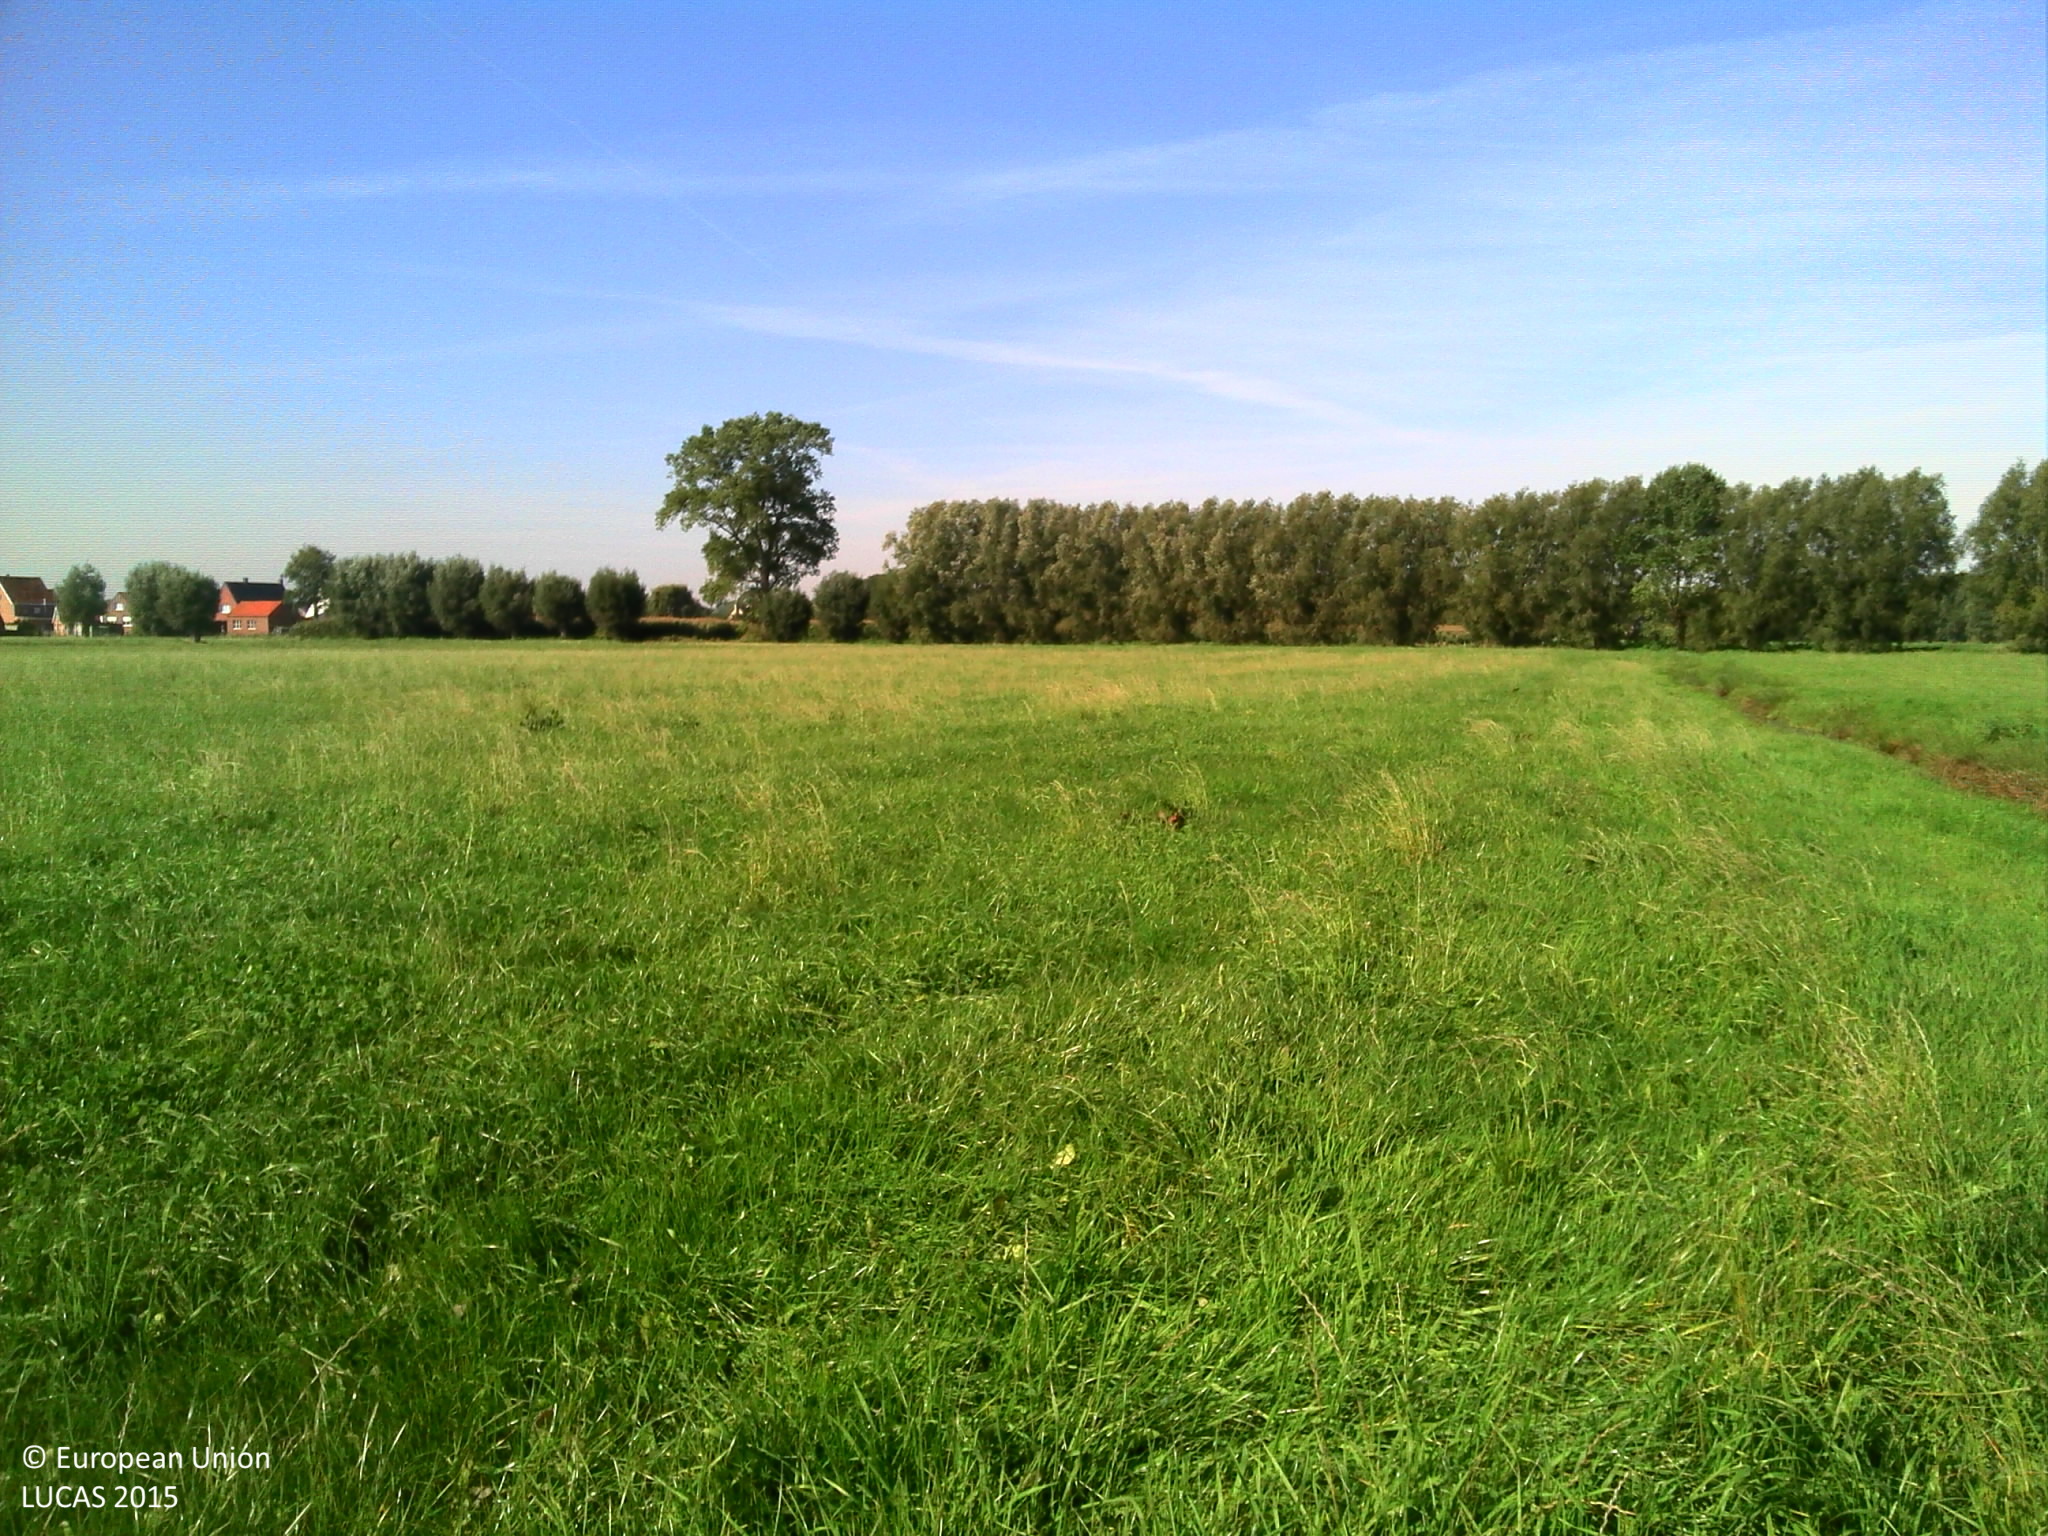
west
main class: Grassland
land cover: Grassland without tree/shrub cover
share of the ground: > 75 %
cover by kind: herbaceous plants 100 %
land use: Agriculture (excluding fallow land and kitchen gardens)
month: September
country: BE
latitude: 51.1477
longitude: 3.4016
